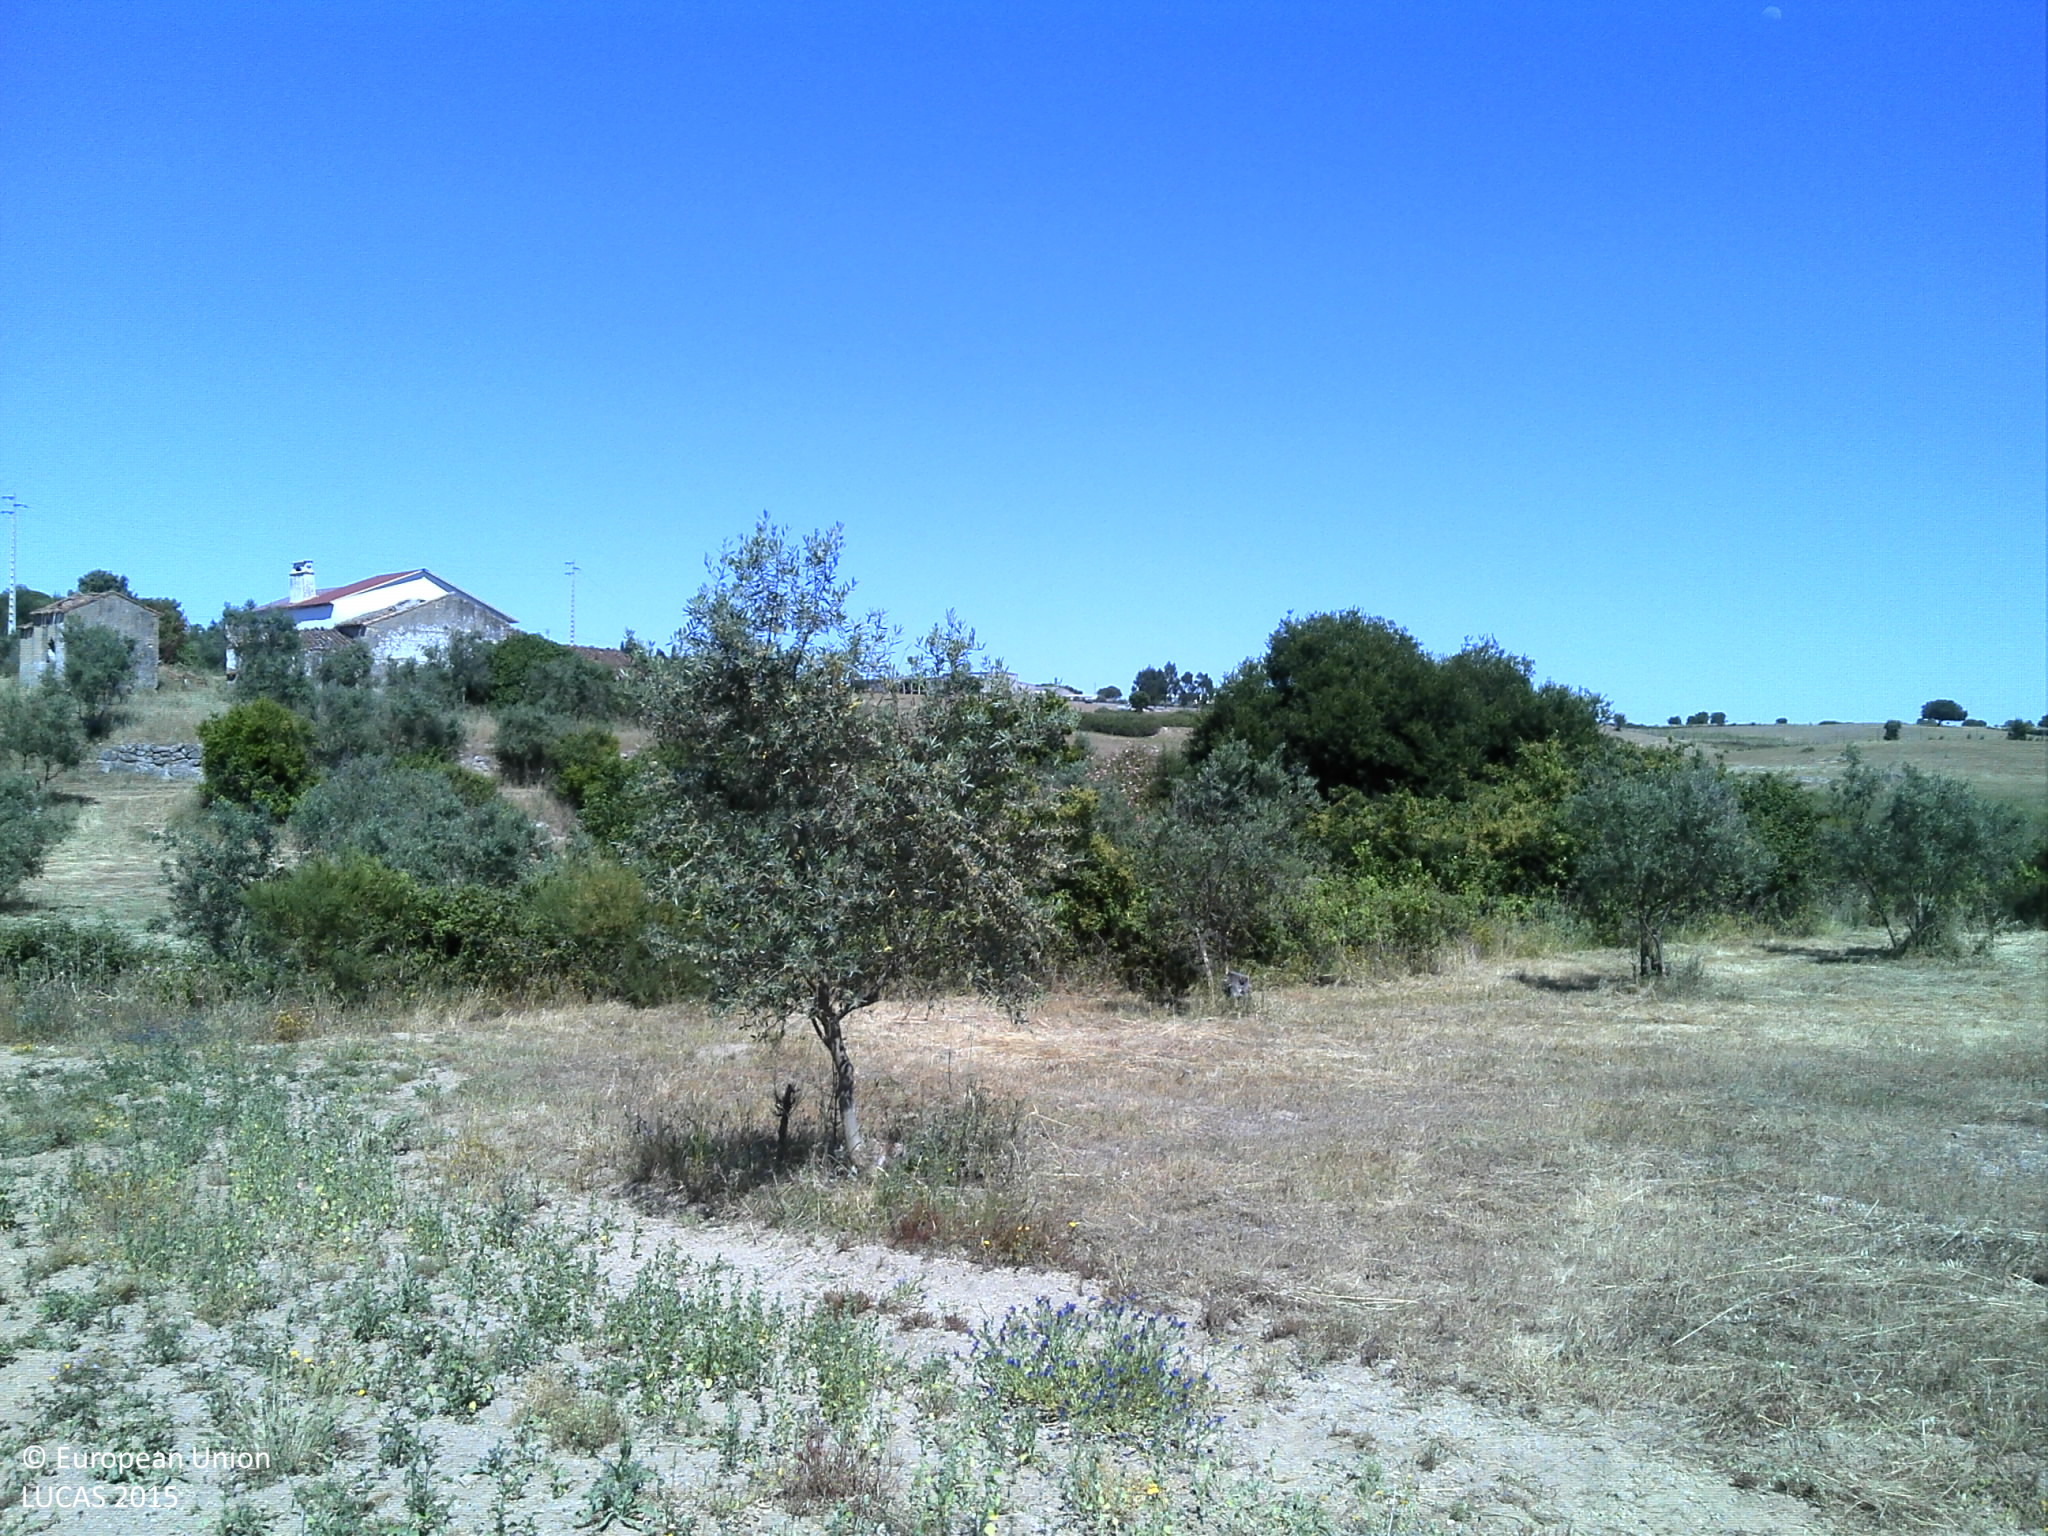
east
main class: Cropland
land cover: Olive groves
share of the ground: 25 - 50 %
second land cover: Grassland without tree/shrub cover
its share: 25 - 50 %
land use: Agriculture (excluding fallow land and kitchen gardens)
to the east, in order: Olive groves; Grassland without tree/shrub cover; Shrubland with sparse tree cover; Olive groves; Shrubland with sparse tree cover; Dry stone walls; Fences; Grassland without tree/shrub cover; Shrubland without tree cover; Rivers and streams; Shrubland without tree cover; Grassland without tree/shrub cover; Fences; Grassland without tree/shrub cover
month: May
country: PT
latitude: 39.4161
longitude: -7.7170
